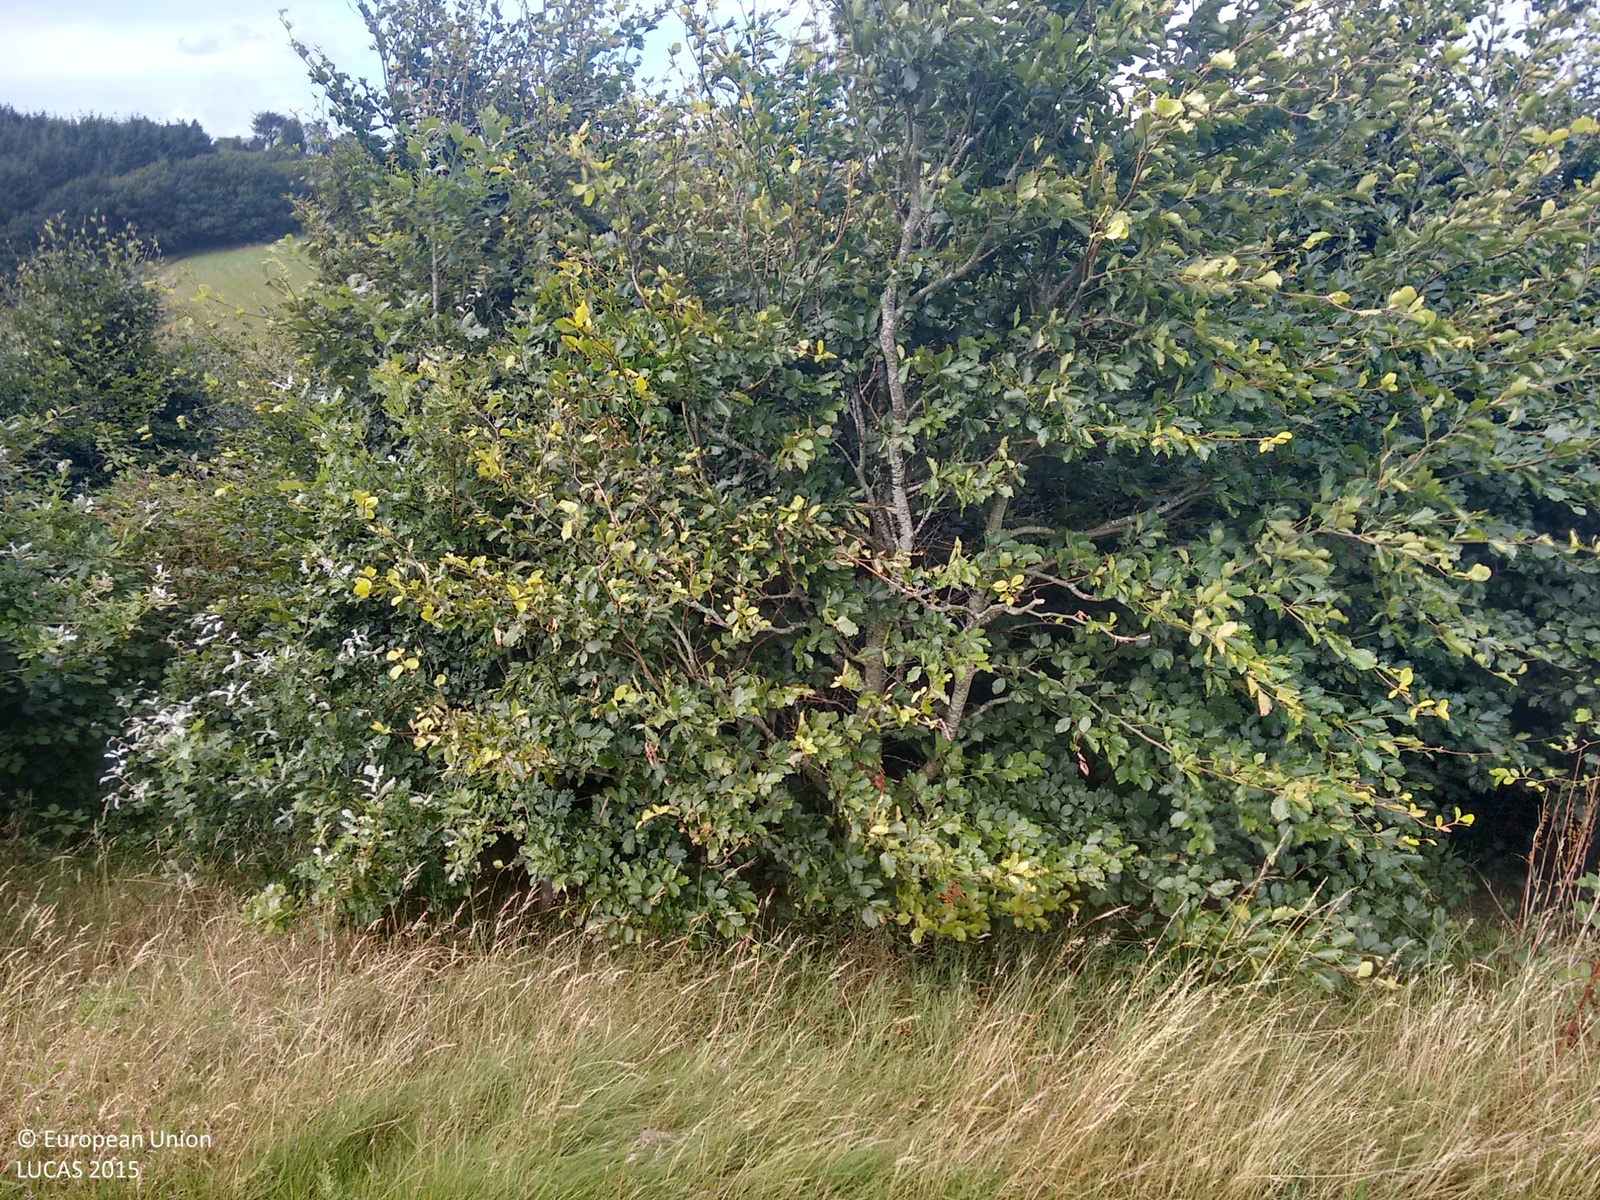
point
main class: Woodland
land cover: Broadleaved woodland
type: mesophytic deciduous forest
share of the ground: > 75 %
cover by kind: broadleaved forest trees 100 %
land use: Forestry
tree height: < 5 m
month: August
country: GB
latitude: 50.3867
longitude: -3.7451
